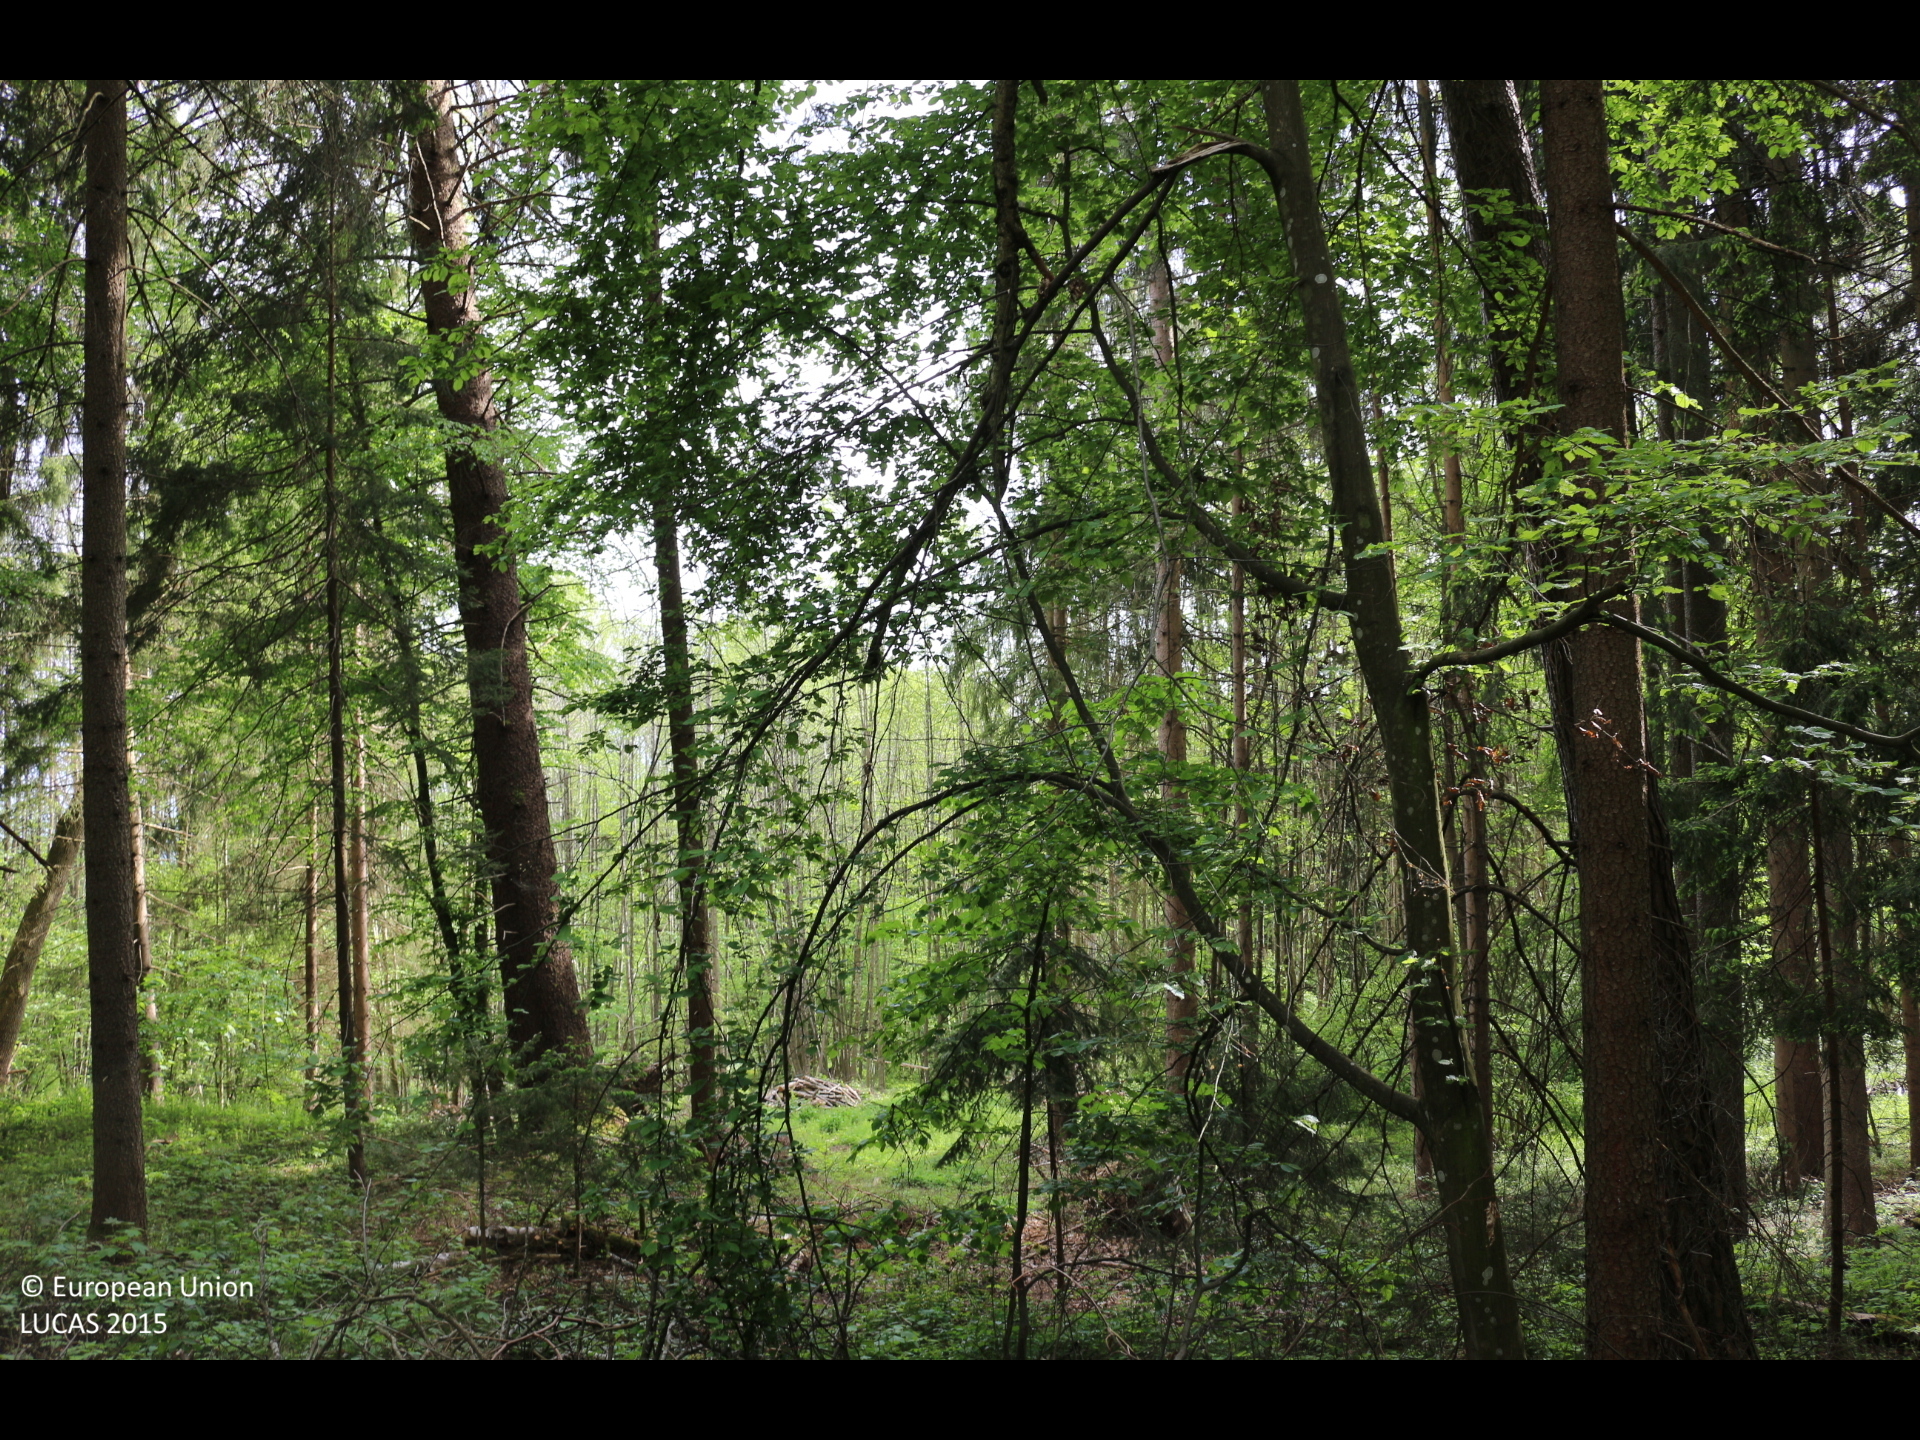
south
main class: Woodland
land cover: Spruce dominated mixed woodland
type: alpine coniferous forest
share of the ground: > 75 %
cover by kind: broadleaved forest trees 60 %, coniferous forest trees 40 %
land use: Forestry
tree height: > 5 m
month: May
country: AT
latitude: 46.6807
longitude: 14.2726
